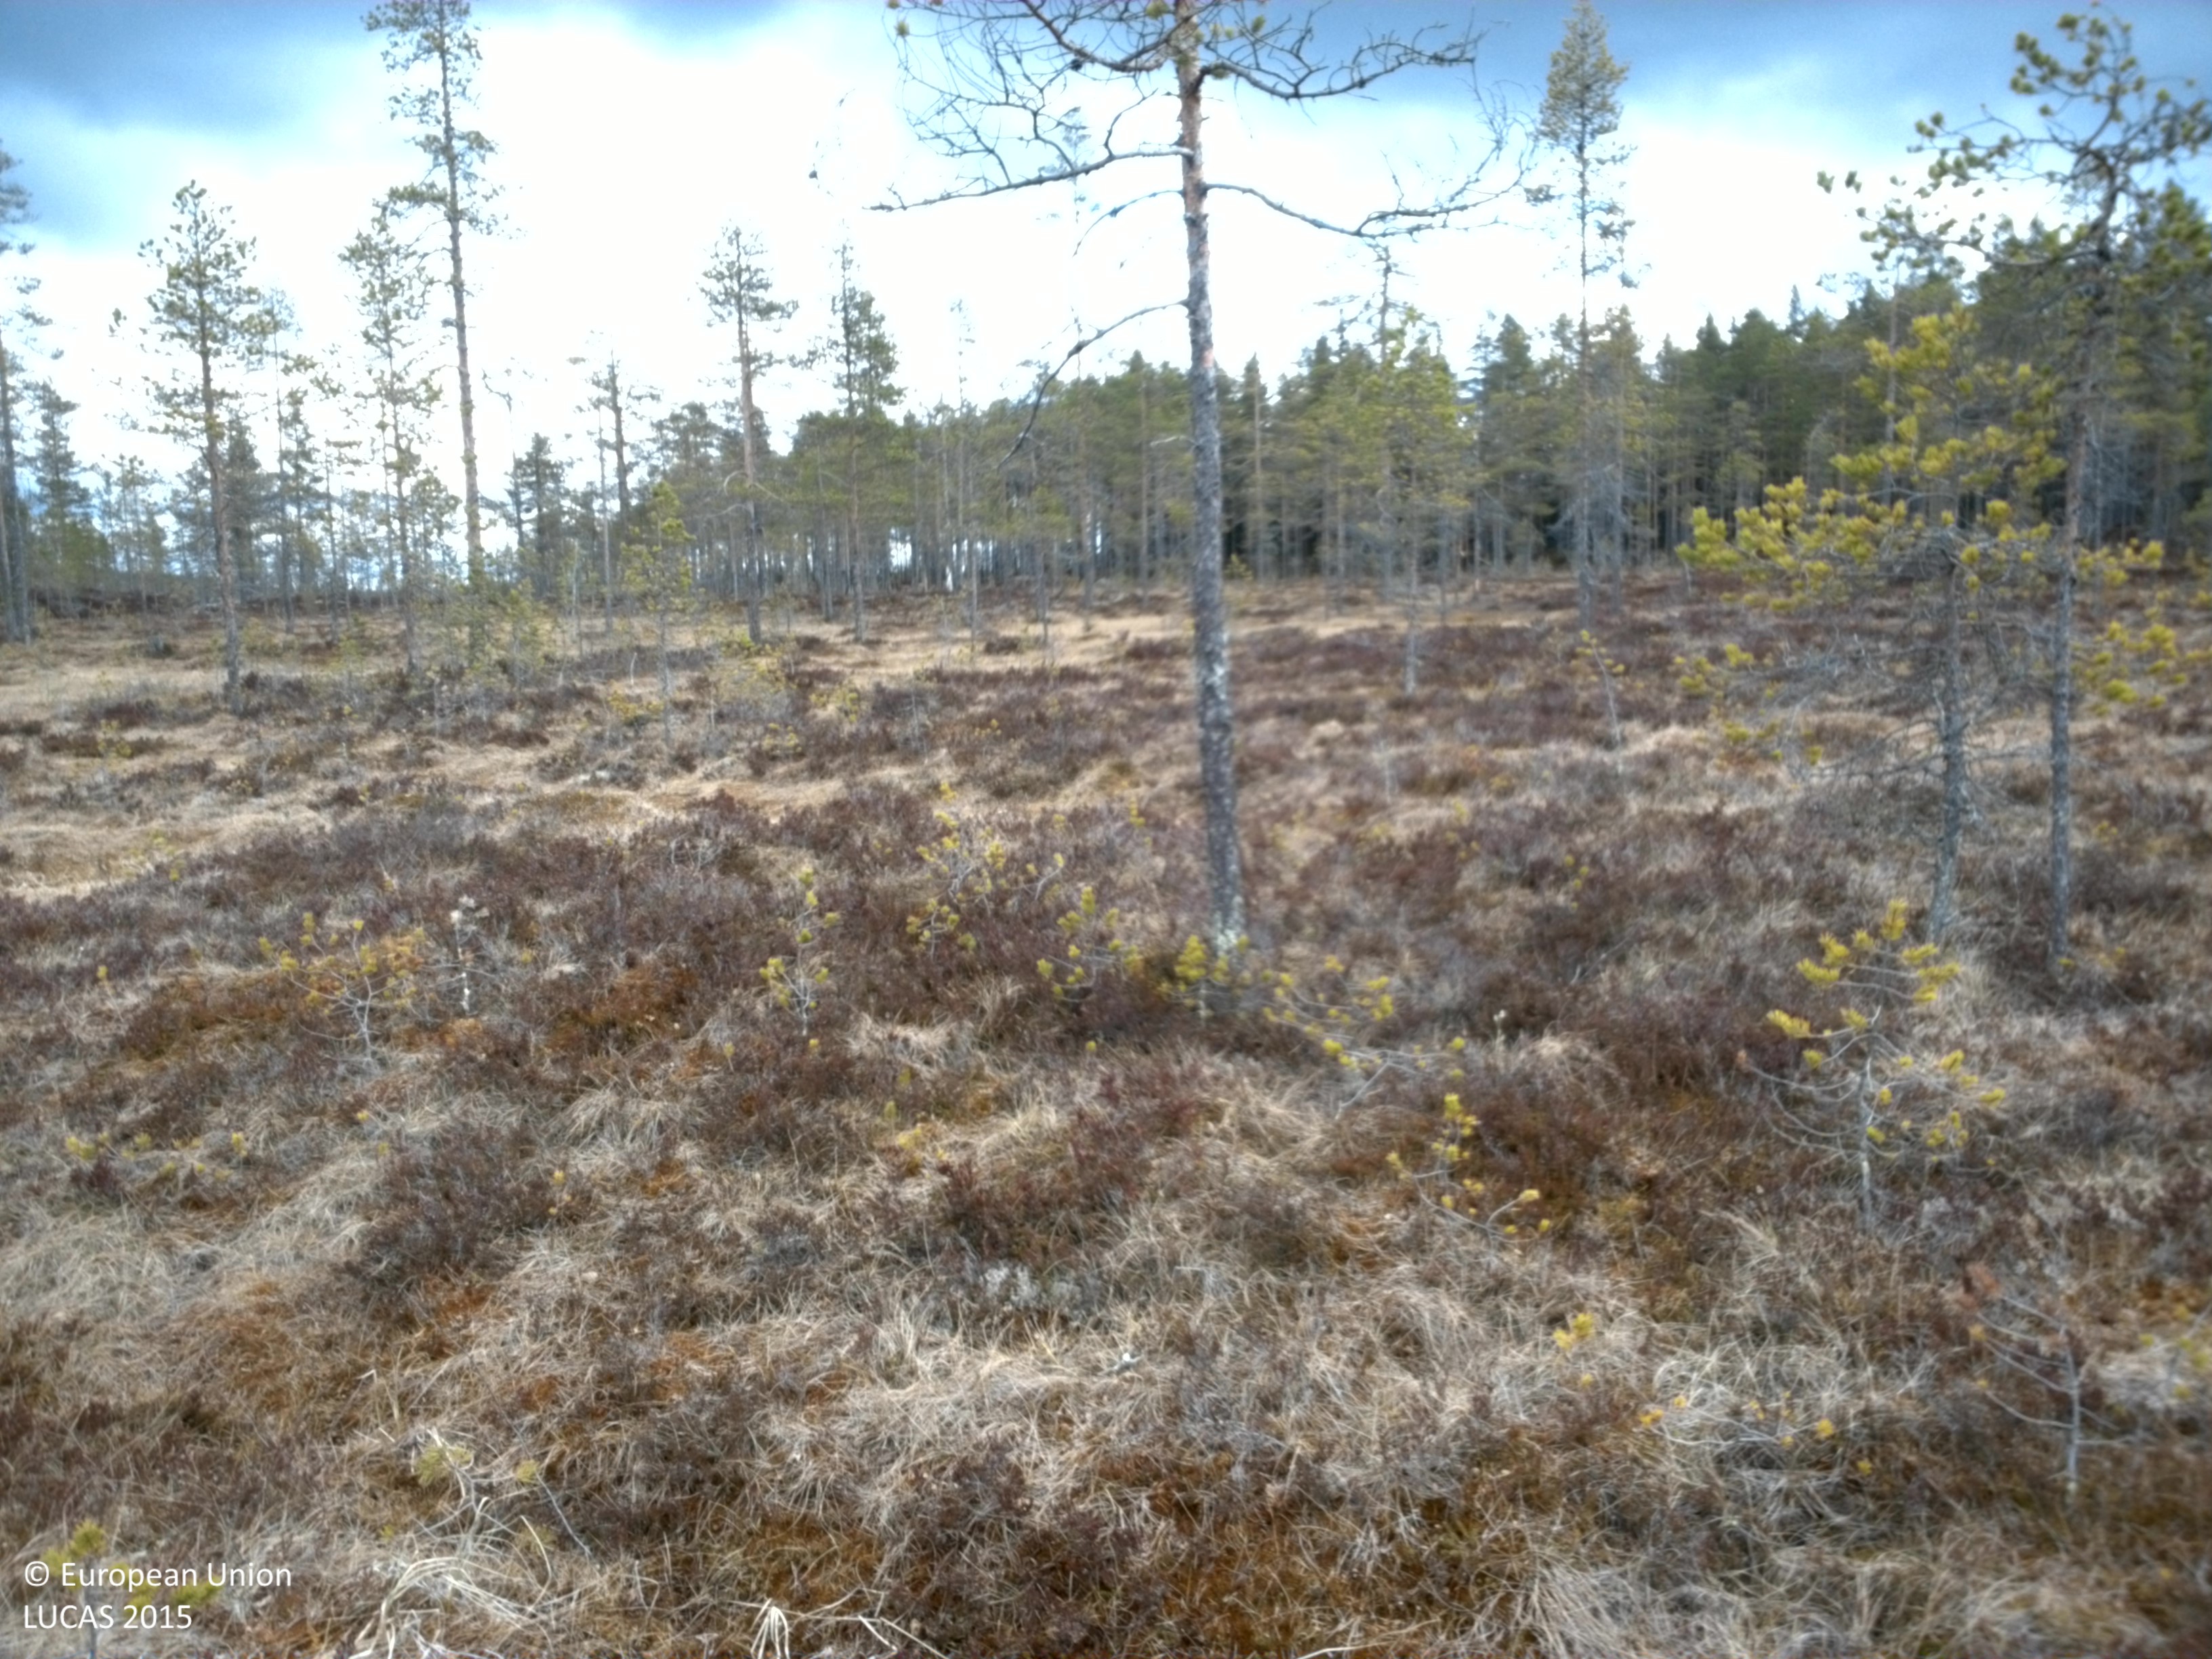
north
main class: Shrubland
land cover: Shrubland with sparse tree cover
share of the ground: > 75 %
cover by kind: shrubs 90 %, coniferous forest trees 5 %, herbaceous plants 5 %
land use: Semi-natural and natural areas not in use
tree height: < 5 m
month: May
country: SE
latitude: 61.0190
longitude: 13.5592
